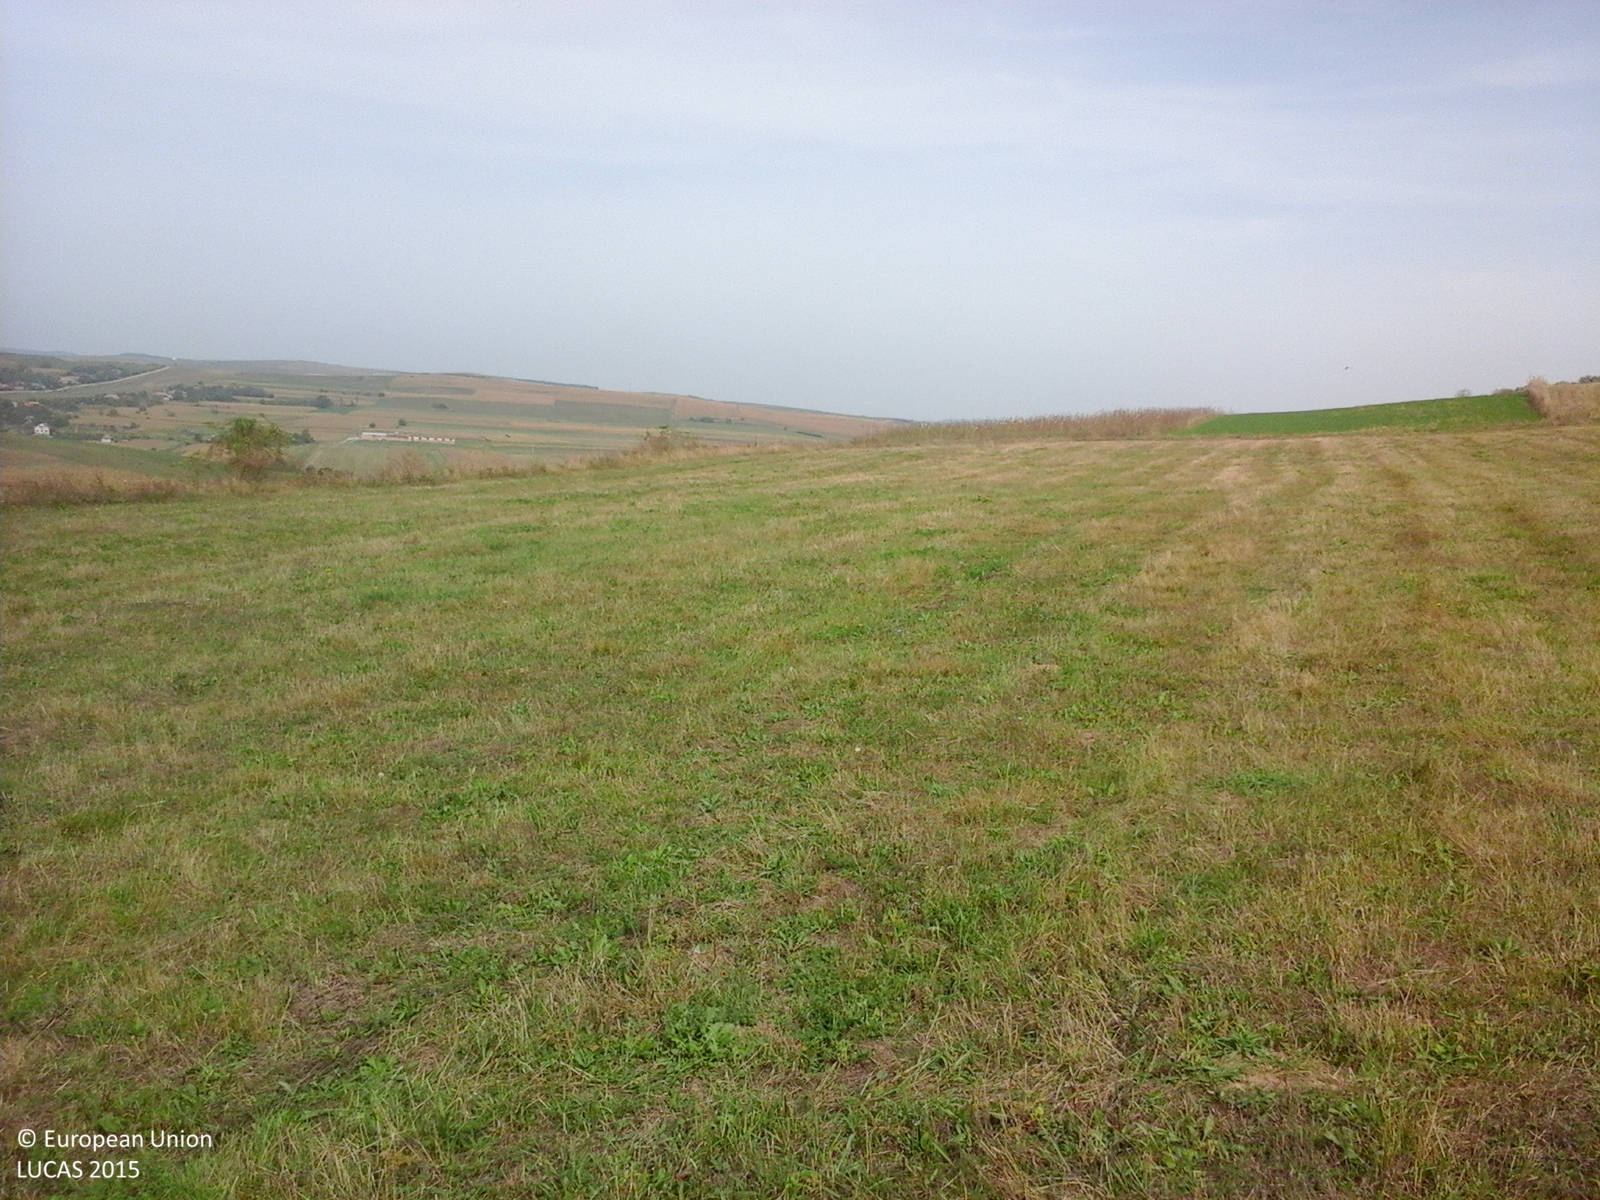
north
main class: Grassland
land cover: Grassland without tree/shrub cover
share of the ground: > 75 %
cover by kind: herbaceous plants 100 %
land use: Agriculture (excluding fallow land and kitchen gardens)
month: September
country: RO
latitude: 46.9007
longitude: 24.1679
